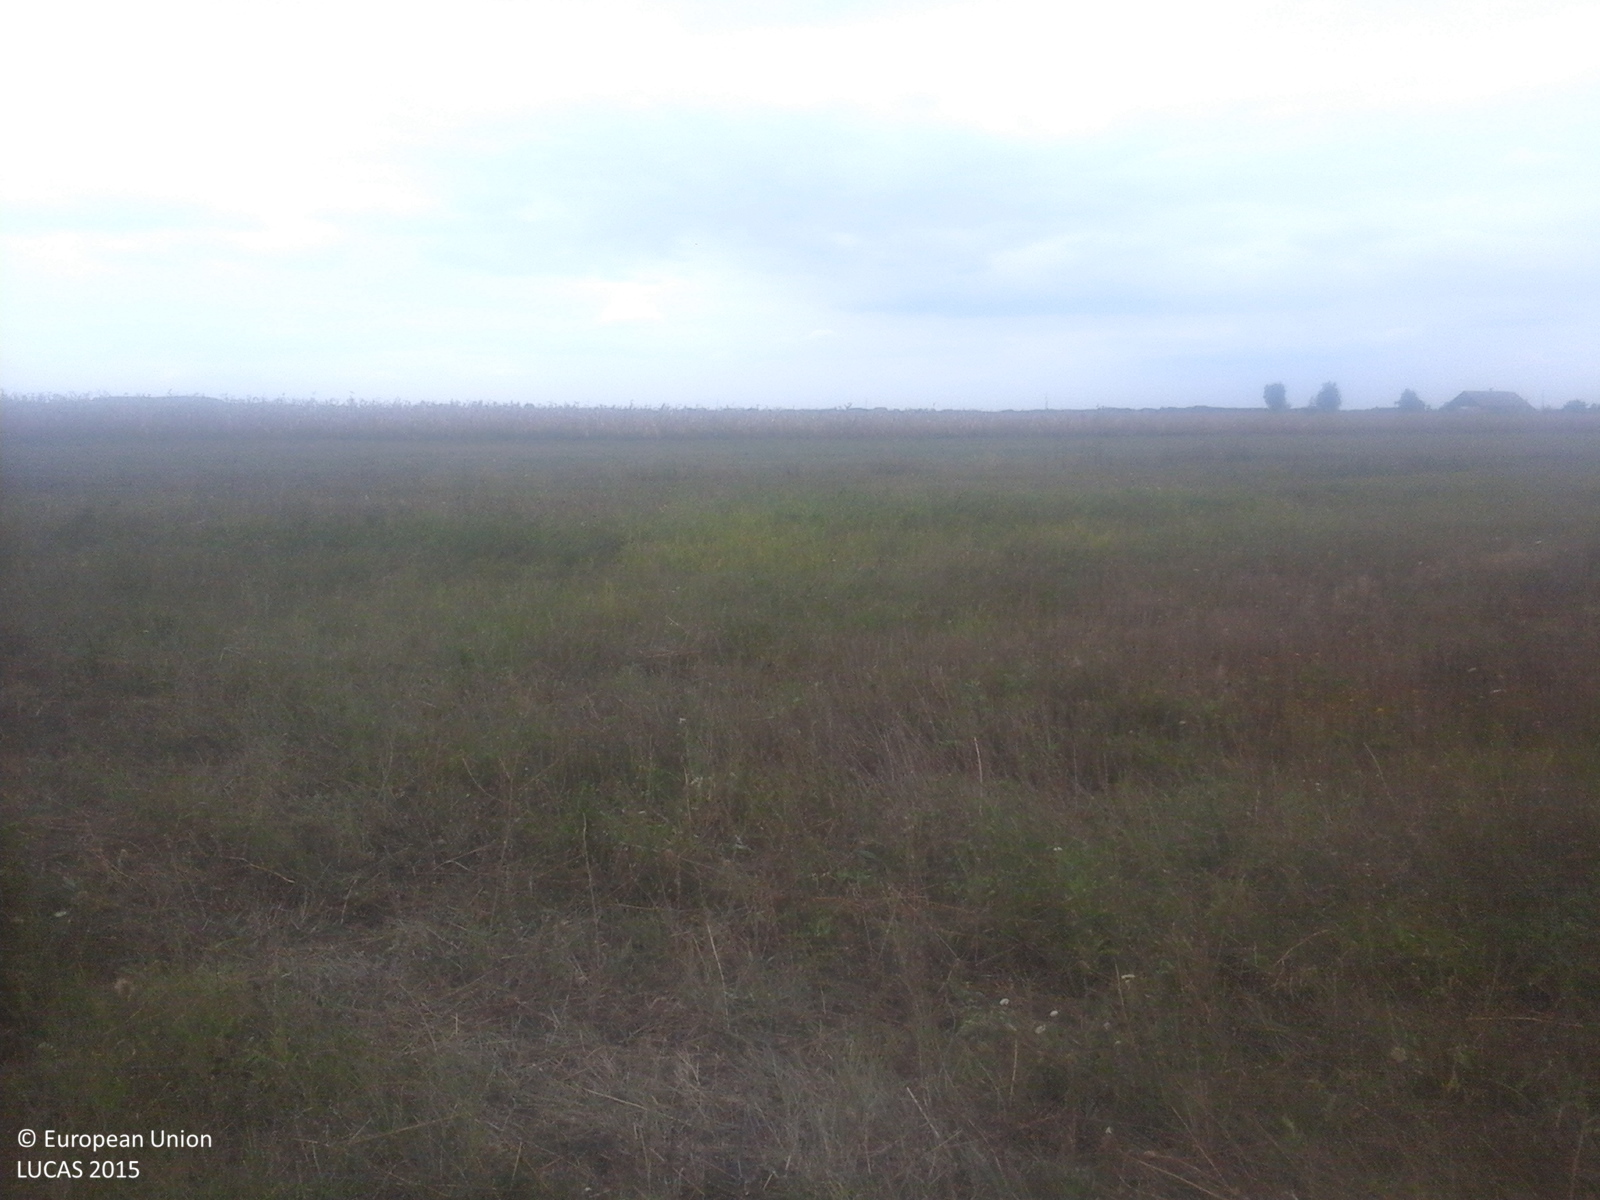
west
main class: Grassland
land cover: Grassland without tree/shrub cover
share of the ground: > 75 %
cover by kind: herbaceous plants 100 %
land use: Agriculture (excluding fallow land and kitchen gardens)
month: September
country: RO
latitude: 47.7469
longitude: 22.8006
